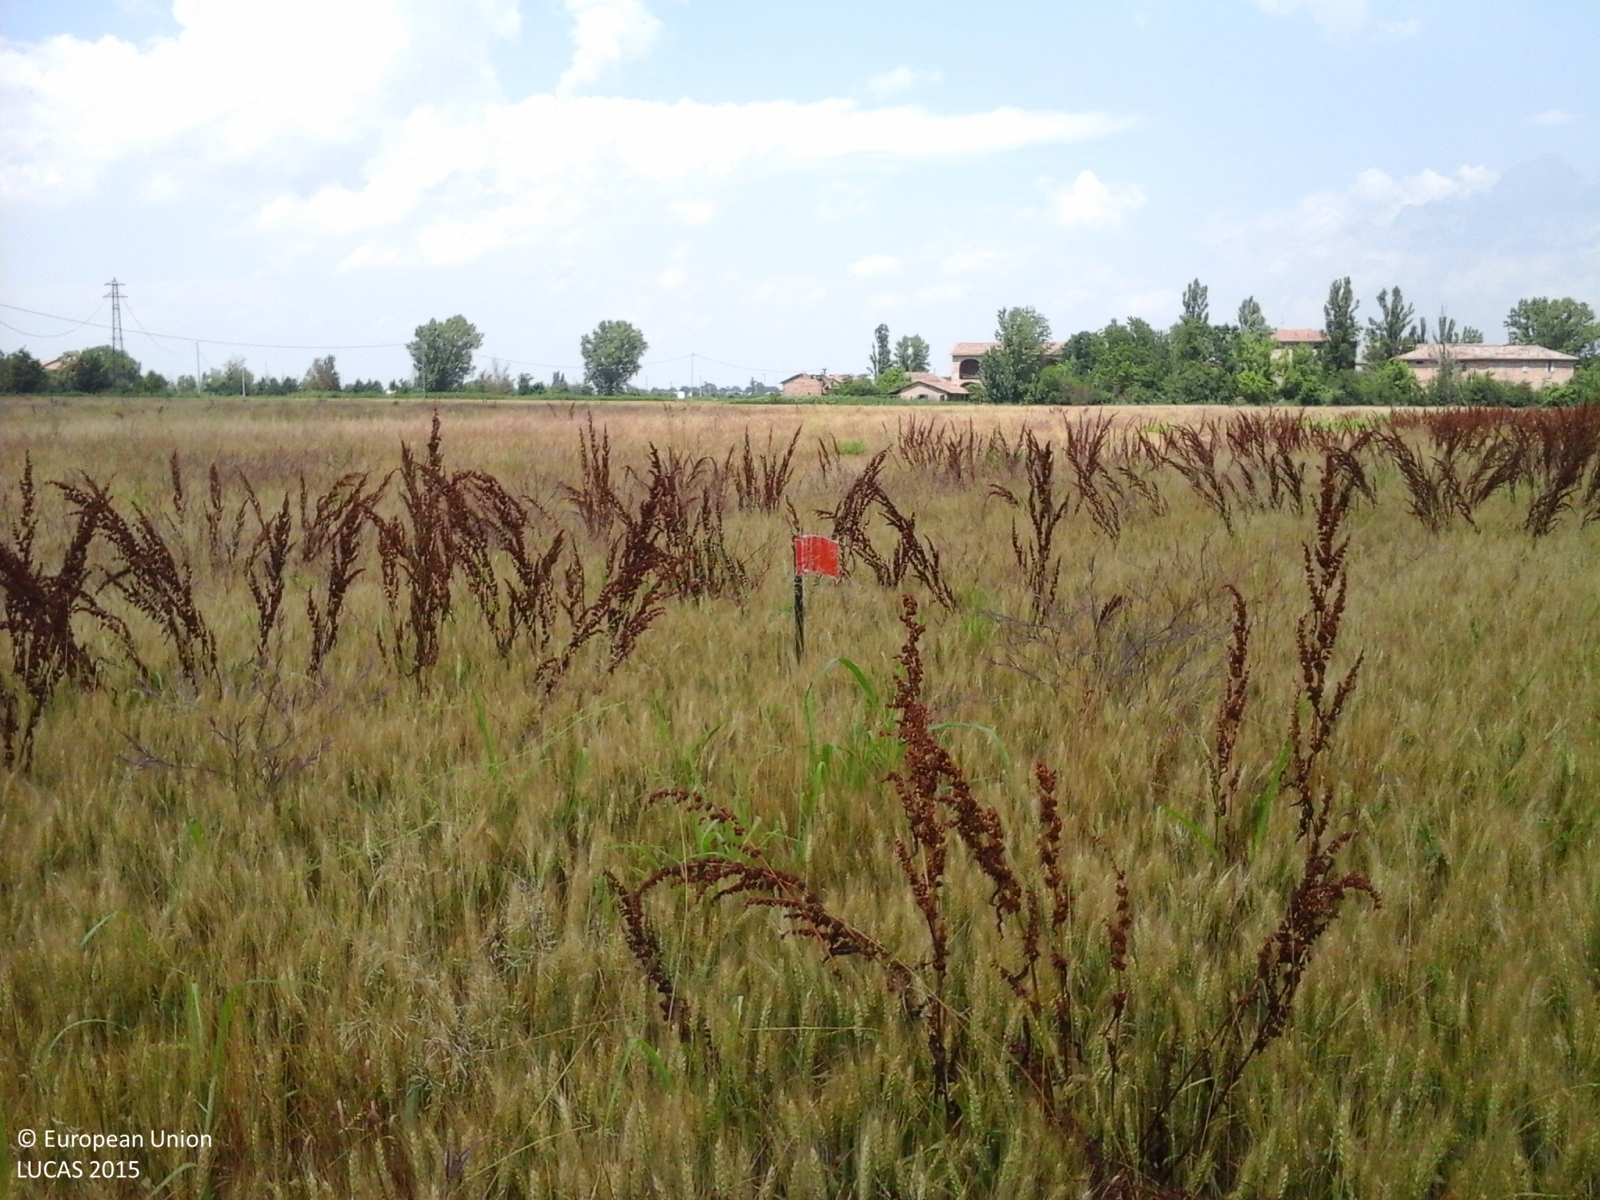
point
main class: Cropland
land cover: Durum wheat
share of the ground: > 75 %
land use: Agriculture (excluding fallow land and kitchen gardens)
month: June
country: IT
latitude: 44.7818
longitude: 10.5675
